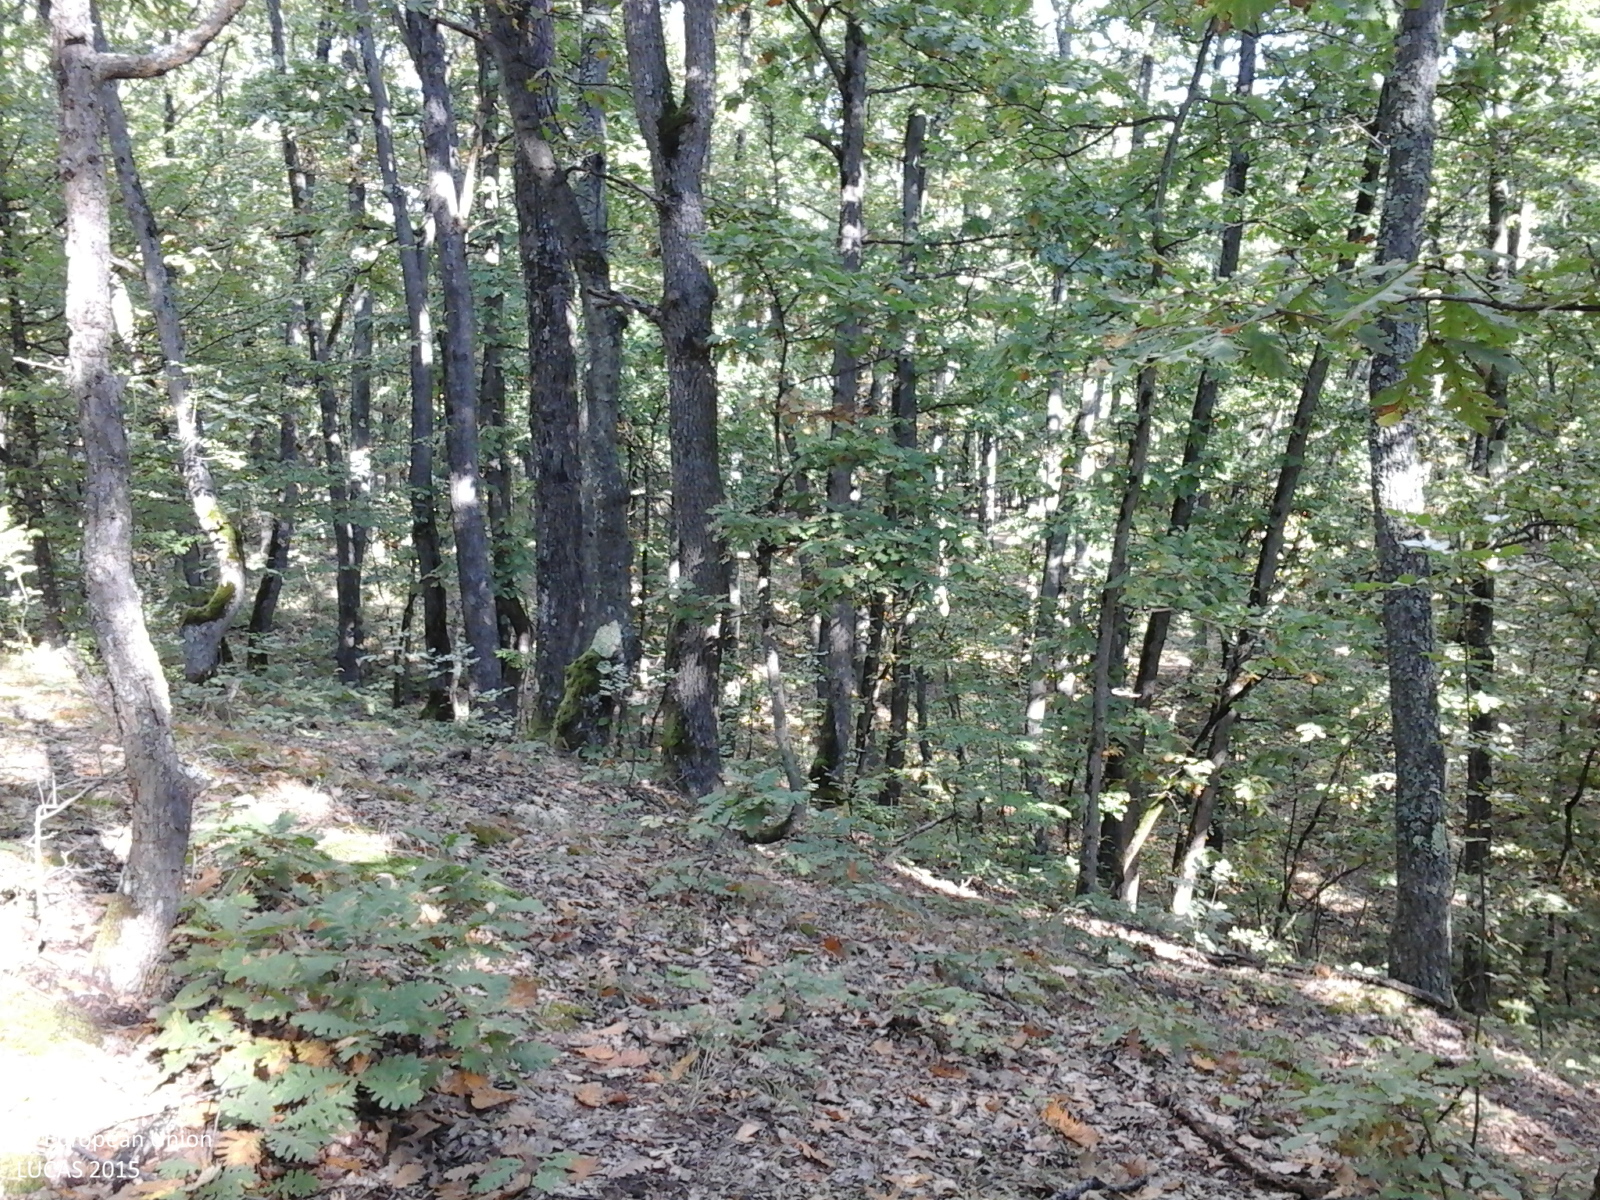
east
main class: Woodland
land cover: Broadleaved woodland
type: acidophilous oak and oak-birch forest
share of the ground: > 75 %
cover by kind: broadleaved forest trees 100 %
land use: Forestry
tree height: > 5 m
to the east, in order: Broadleaved woodland
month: September
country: RO
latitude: 44.9859
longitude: 23.5912
